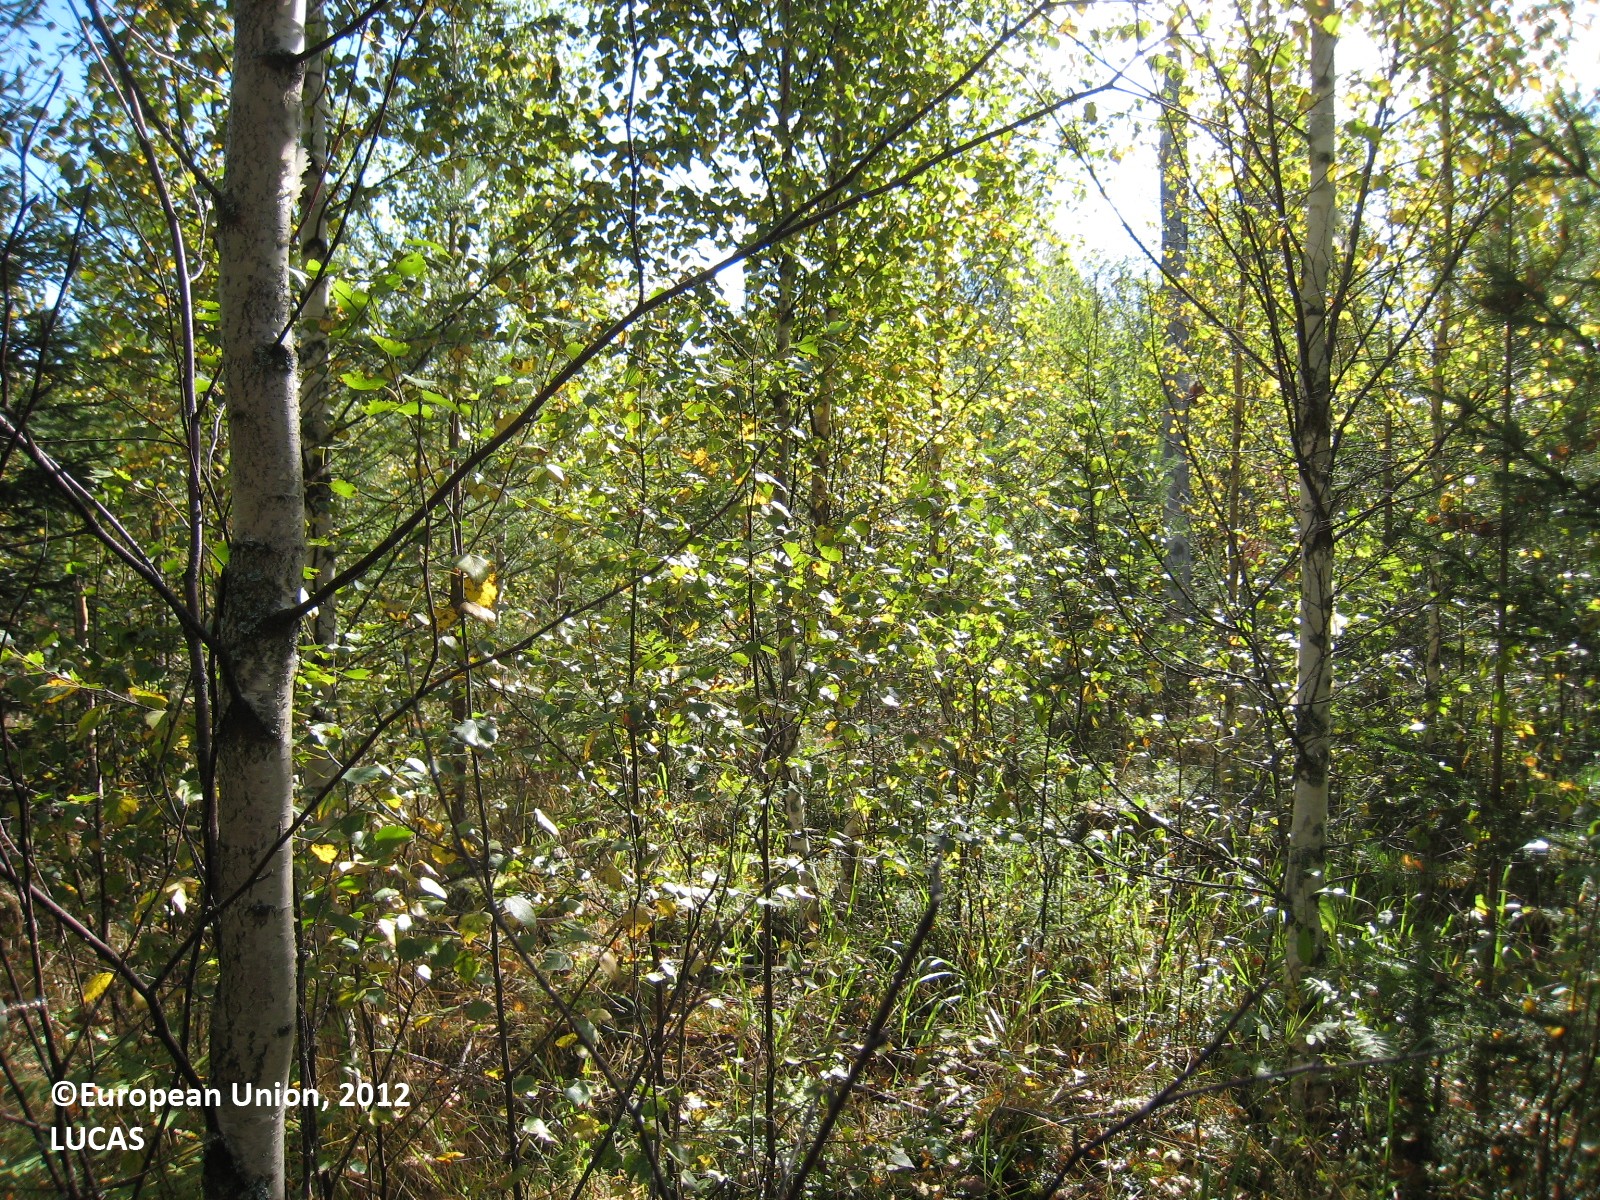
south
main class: Woodland
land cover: Other mixed woodland
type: boreal forest
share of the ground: > 75 %
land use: Forestry
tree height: > 5 m
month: September
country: FI
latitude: 63.0068
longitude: 26.8287
